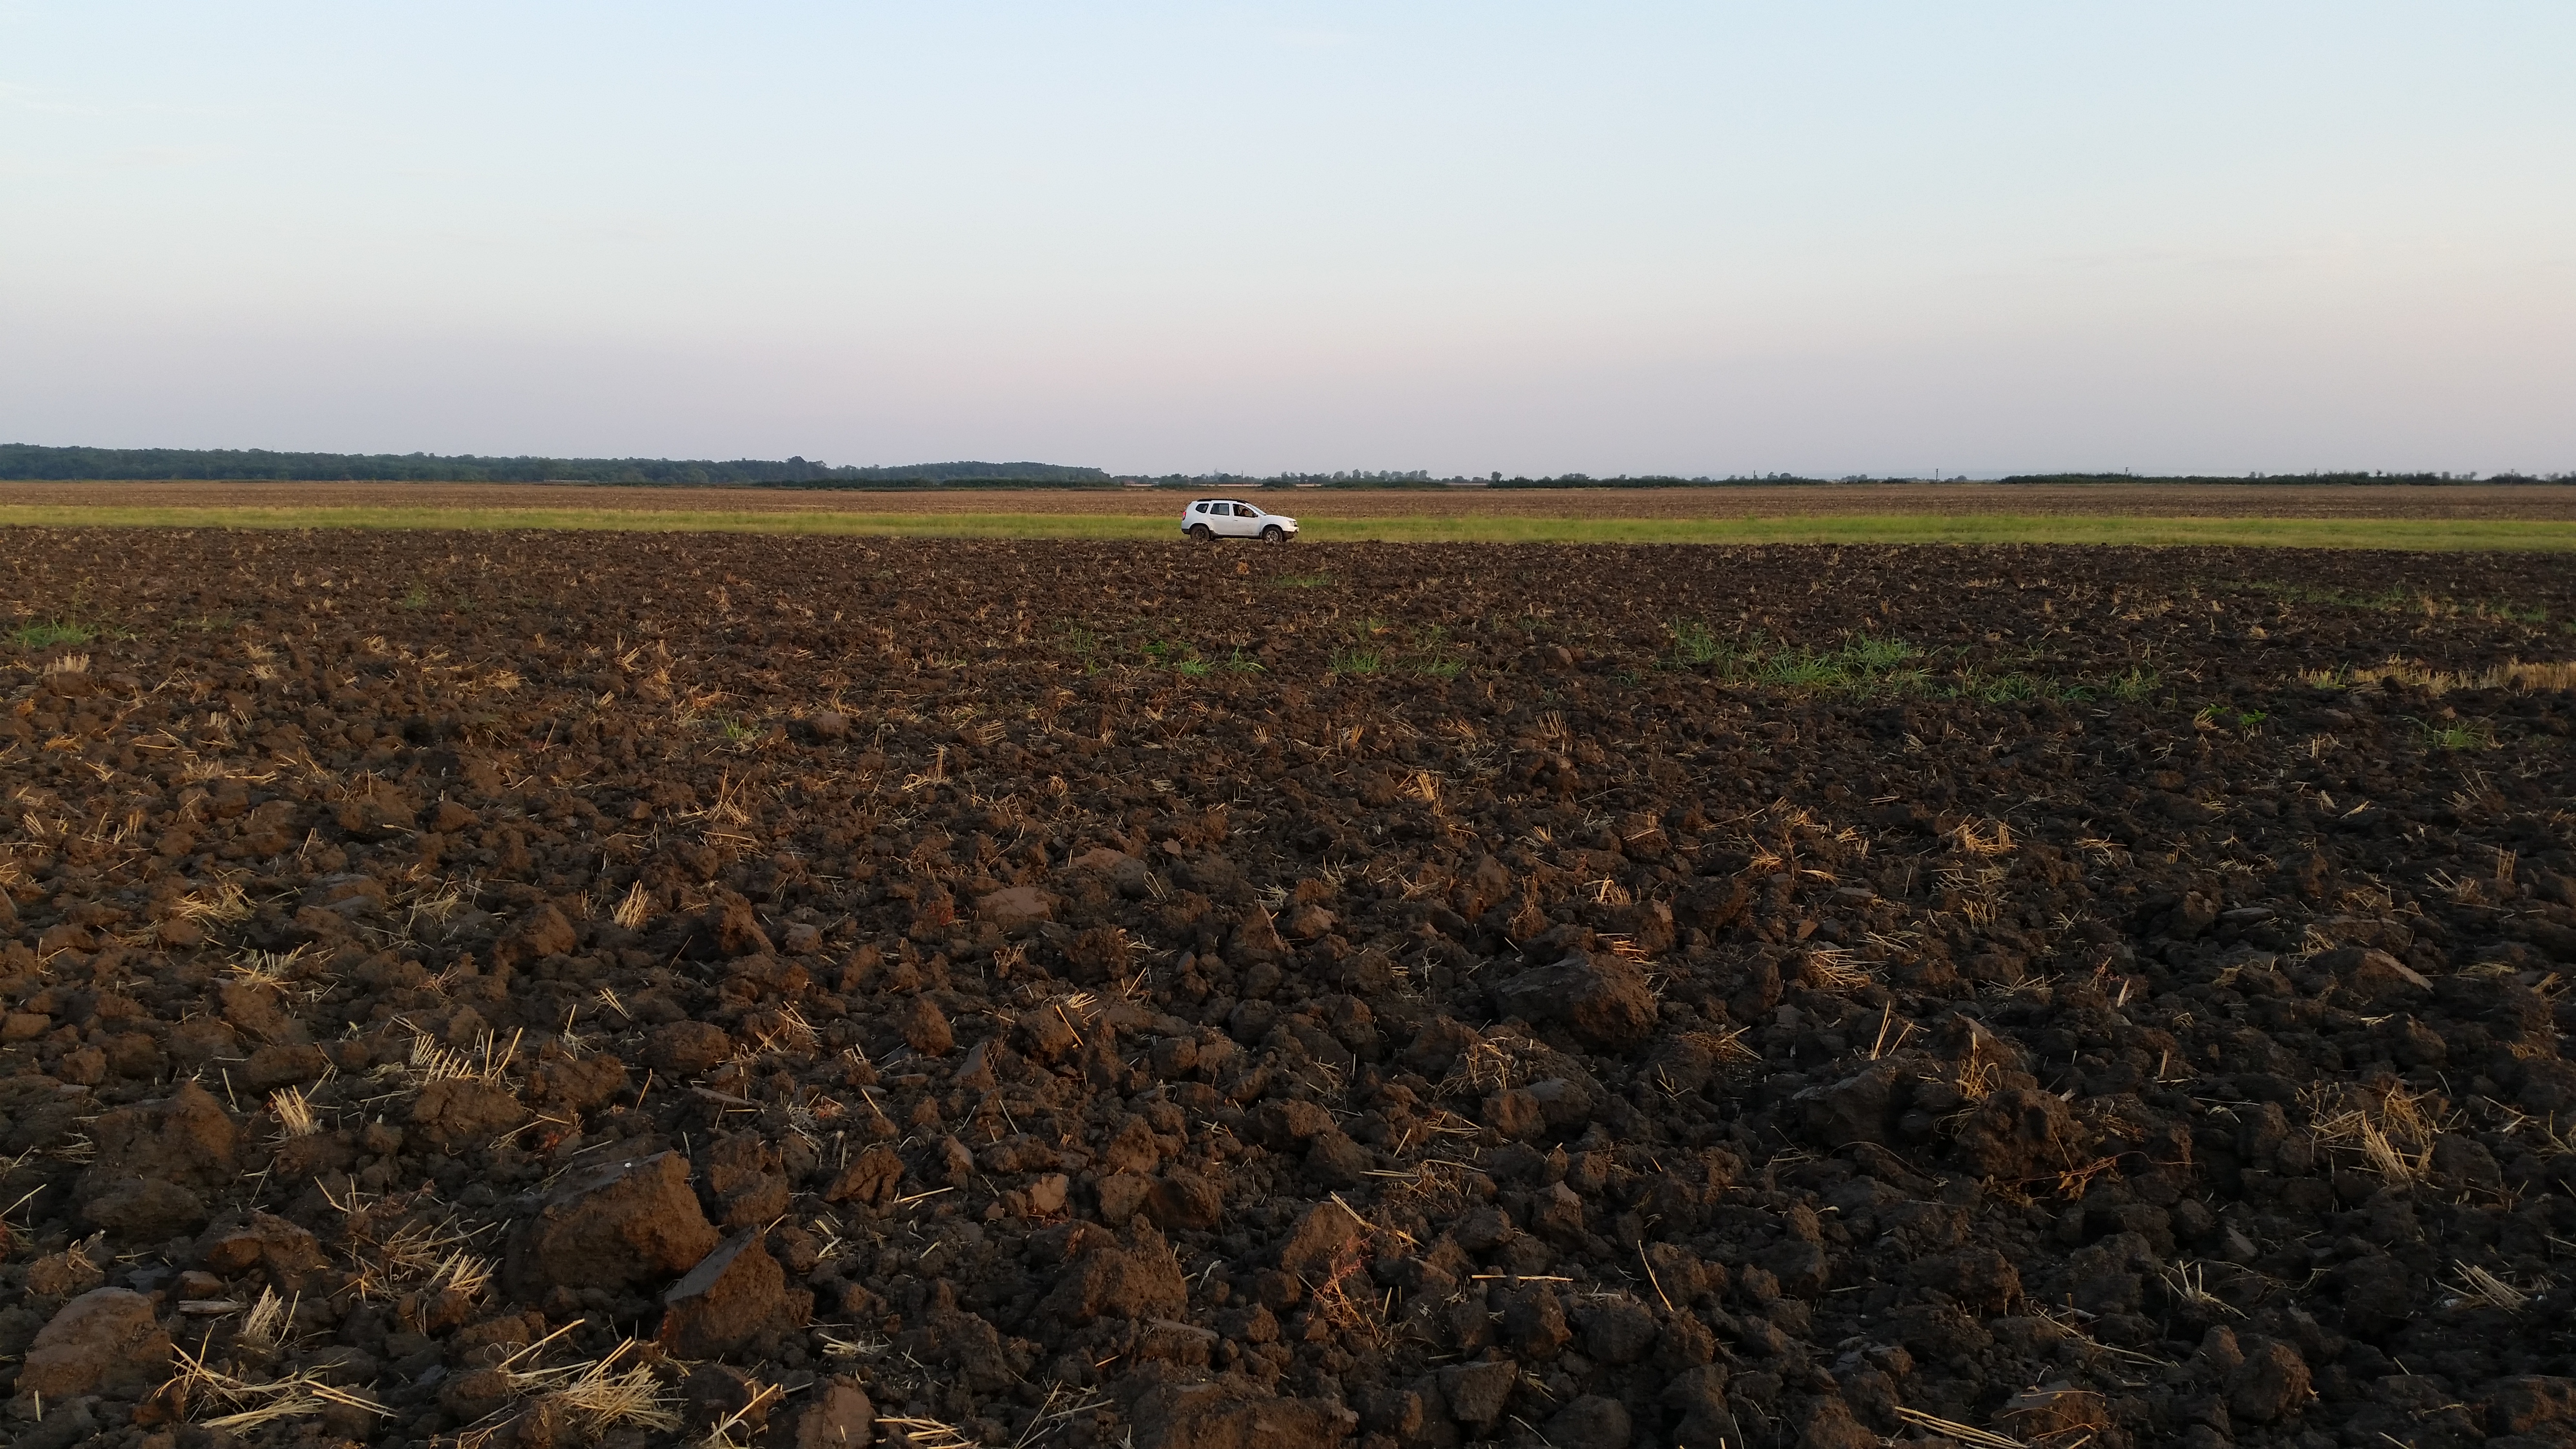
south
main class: Cropland
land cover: Common wheat
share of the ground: < 10 %
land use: Agriculture (excluding fallow land and kitchen gardens)
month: August
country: RO
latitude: 44.0364
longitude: 23.5900
